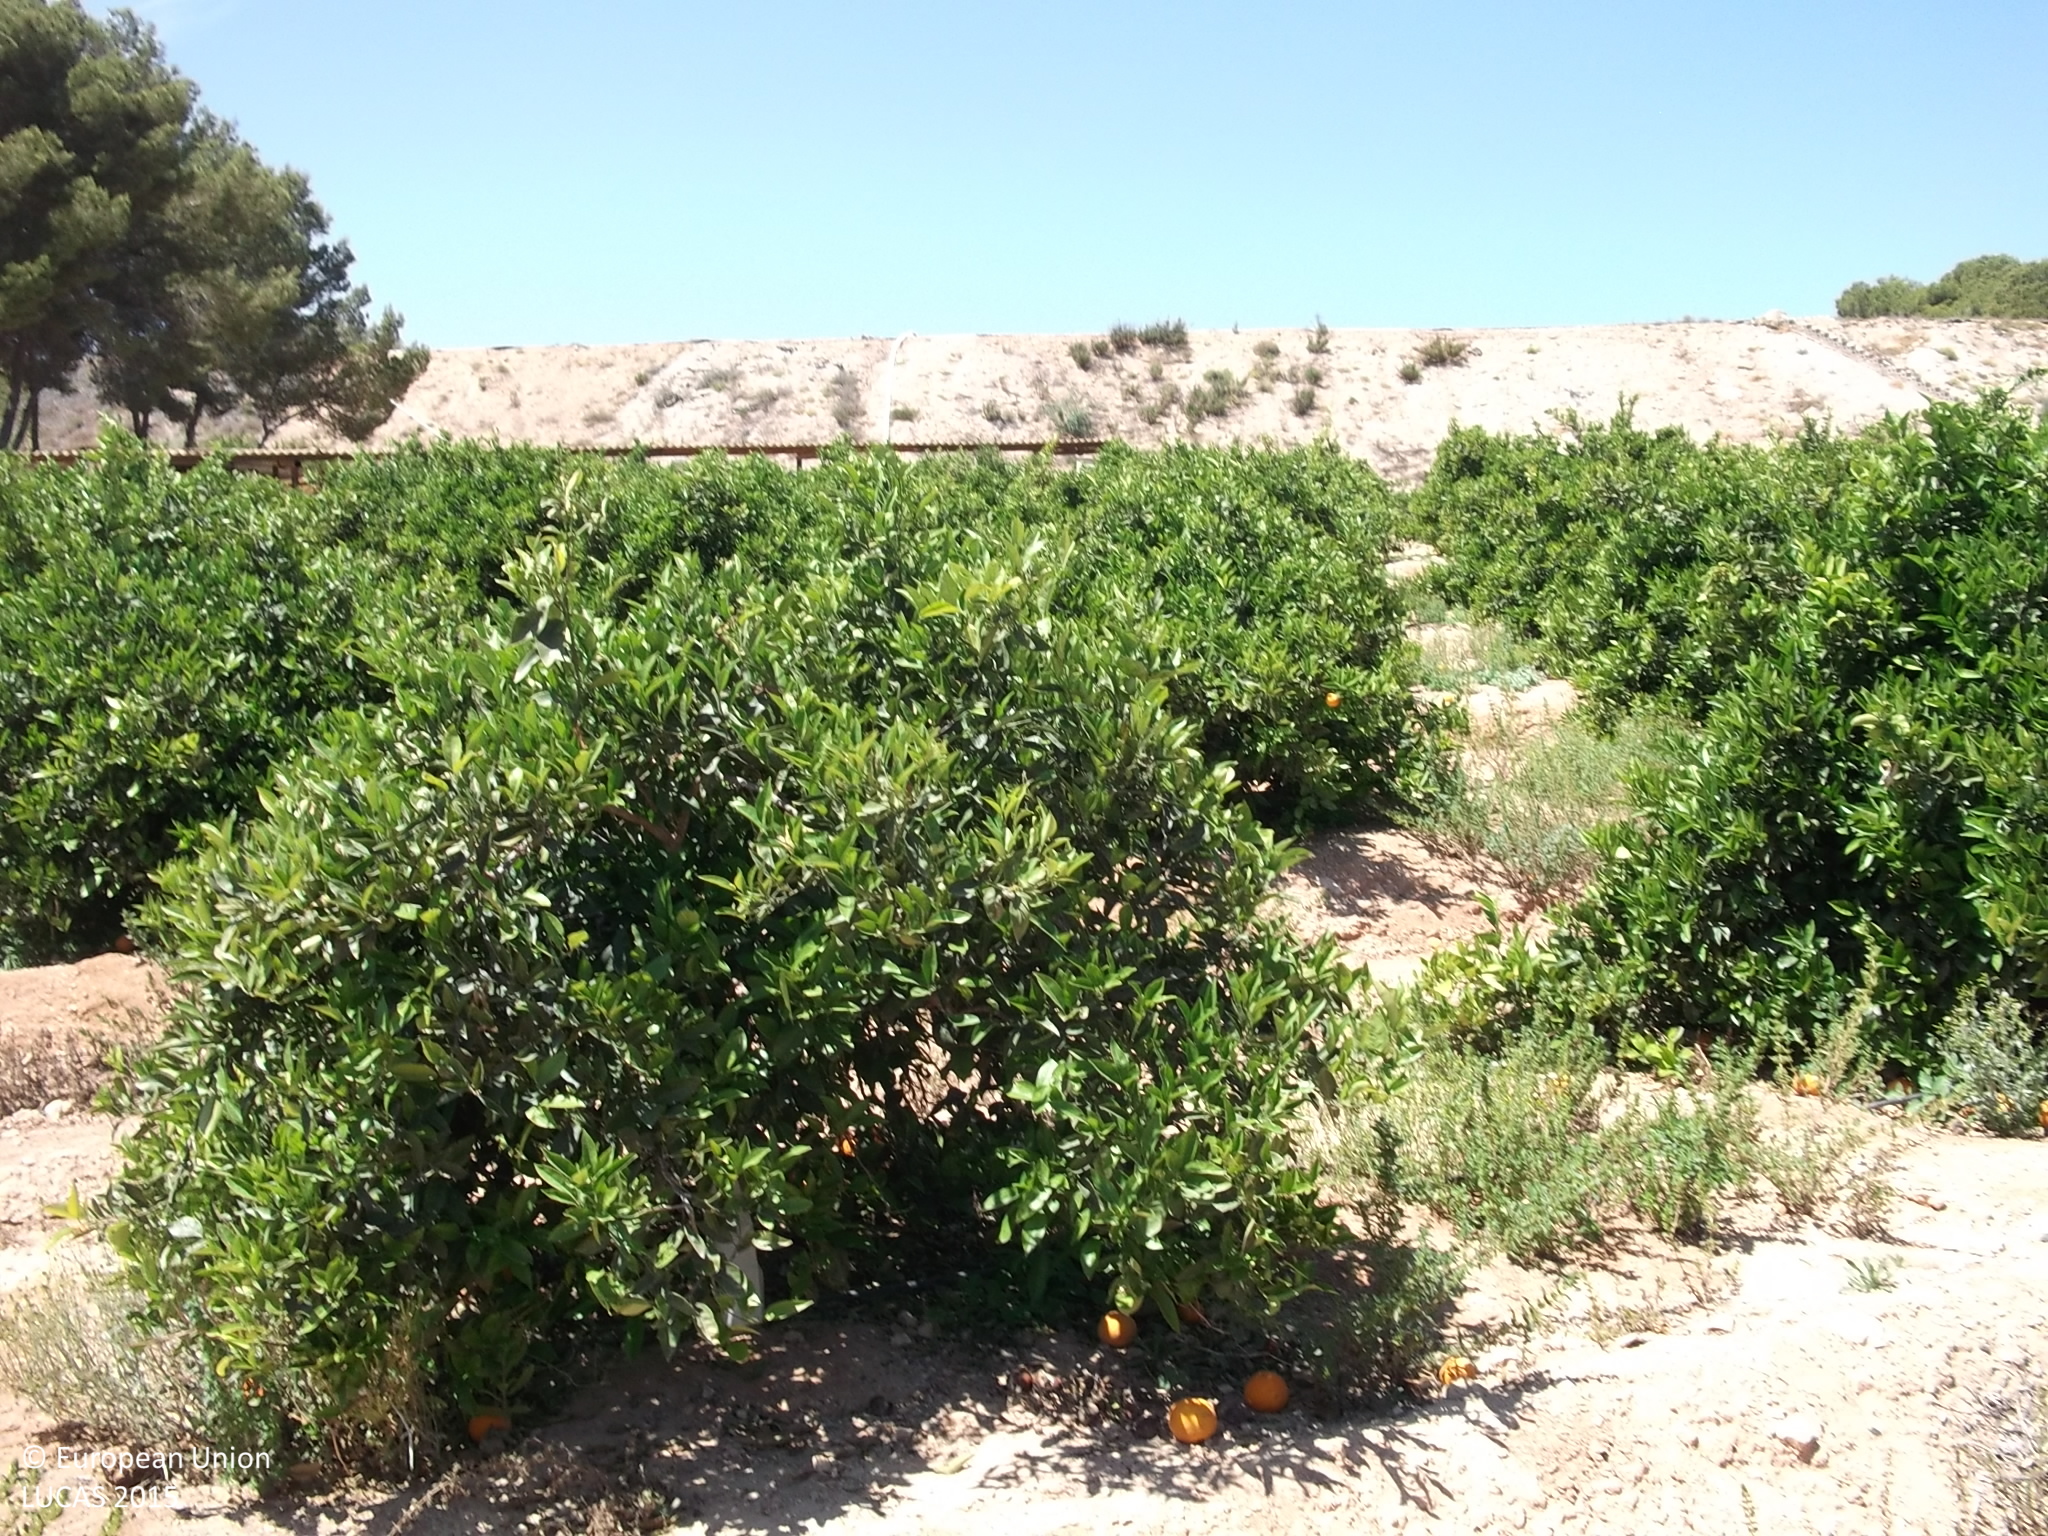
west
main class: Cropland
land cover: Oranges
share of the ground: 10 - 25 %
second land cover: Other bare soil
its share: > 75 %
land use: Agriculture (excluding fallow land and kitchen gardens)
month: May
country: ES
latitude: 37.8962
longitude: -0.8189
